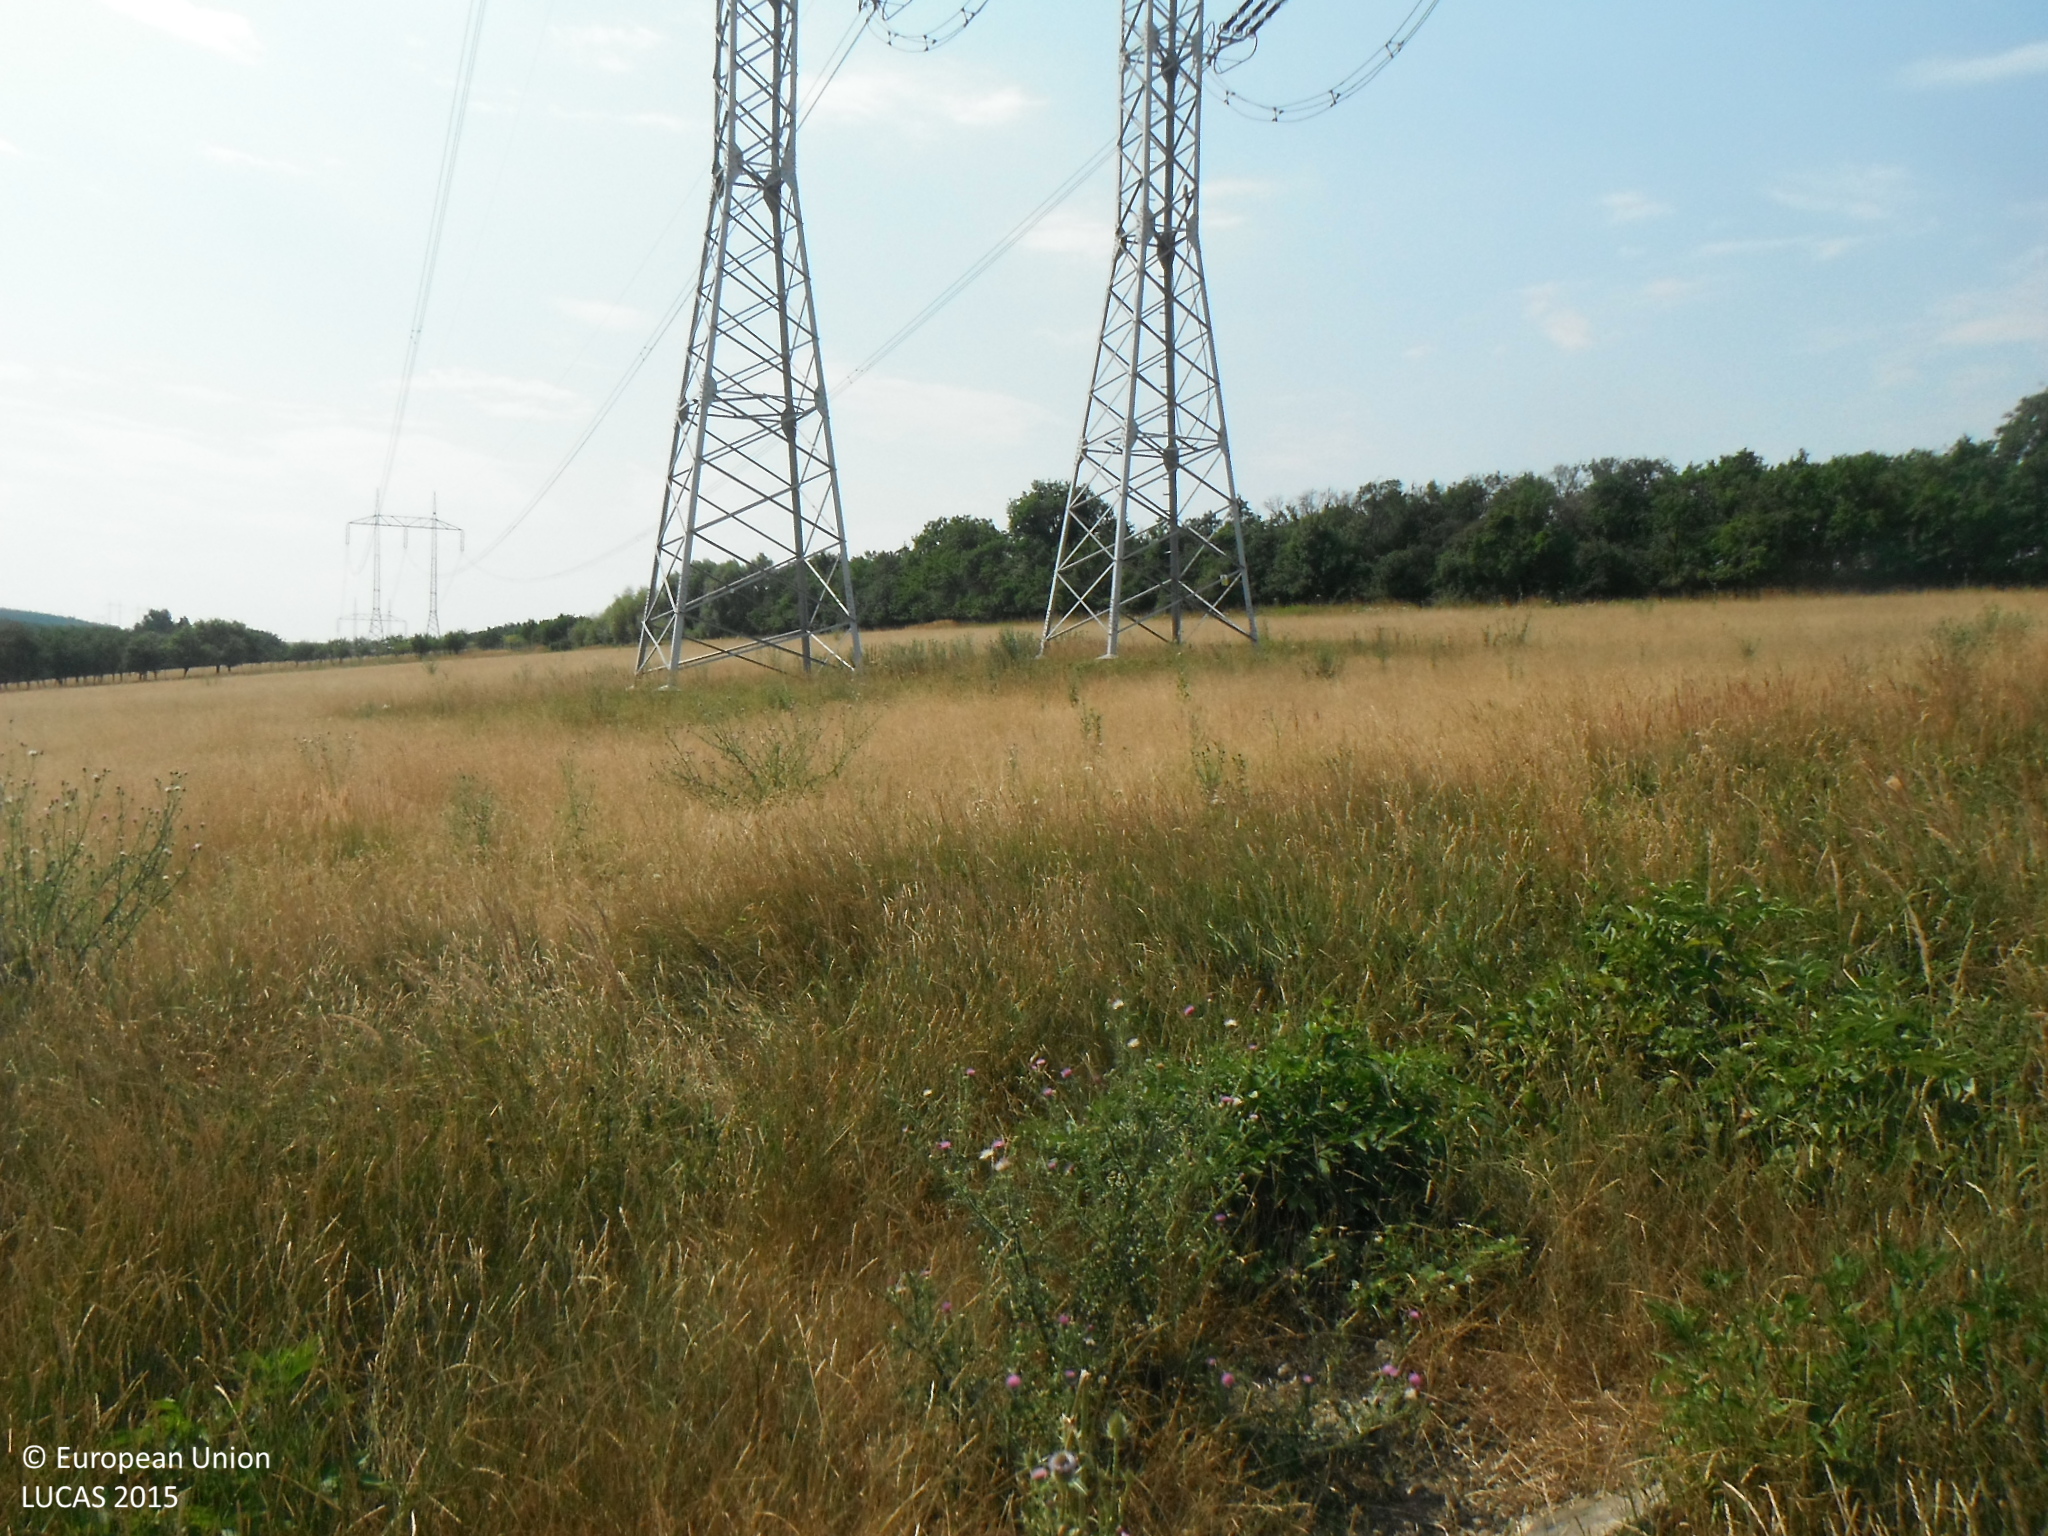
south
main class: Grassland
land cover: Spontaneously vegetated surfaces
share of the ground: > 75 %
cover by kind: herbaceous plants 95 %, shrubs 5 %
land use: Semi-natural and natural areas not in use
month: July
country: SK
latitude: 48.8323
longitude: 17.2711
